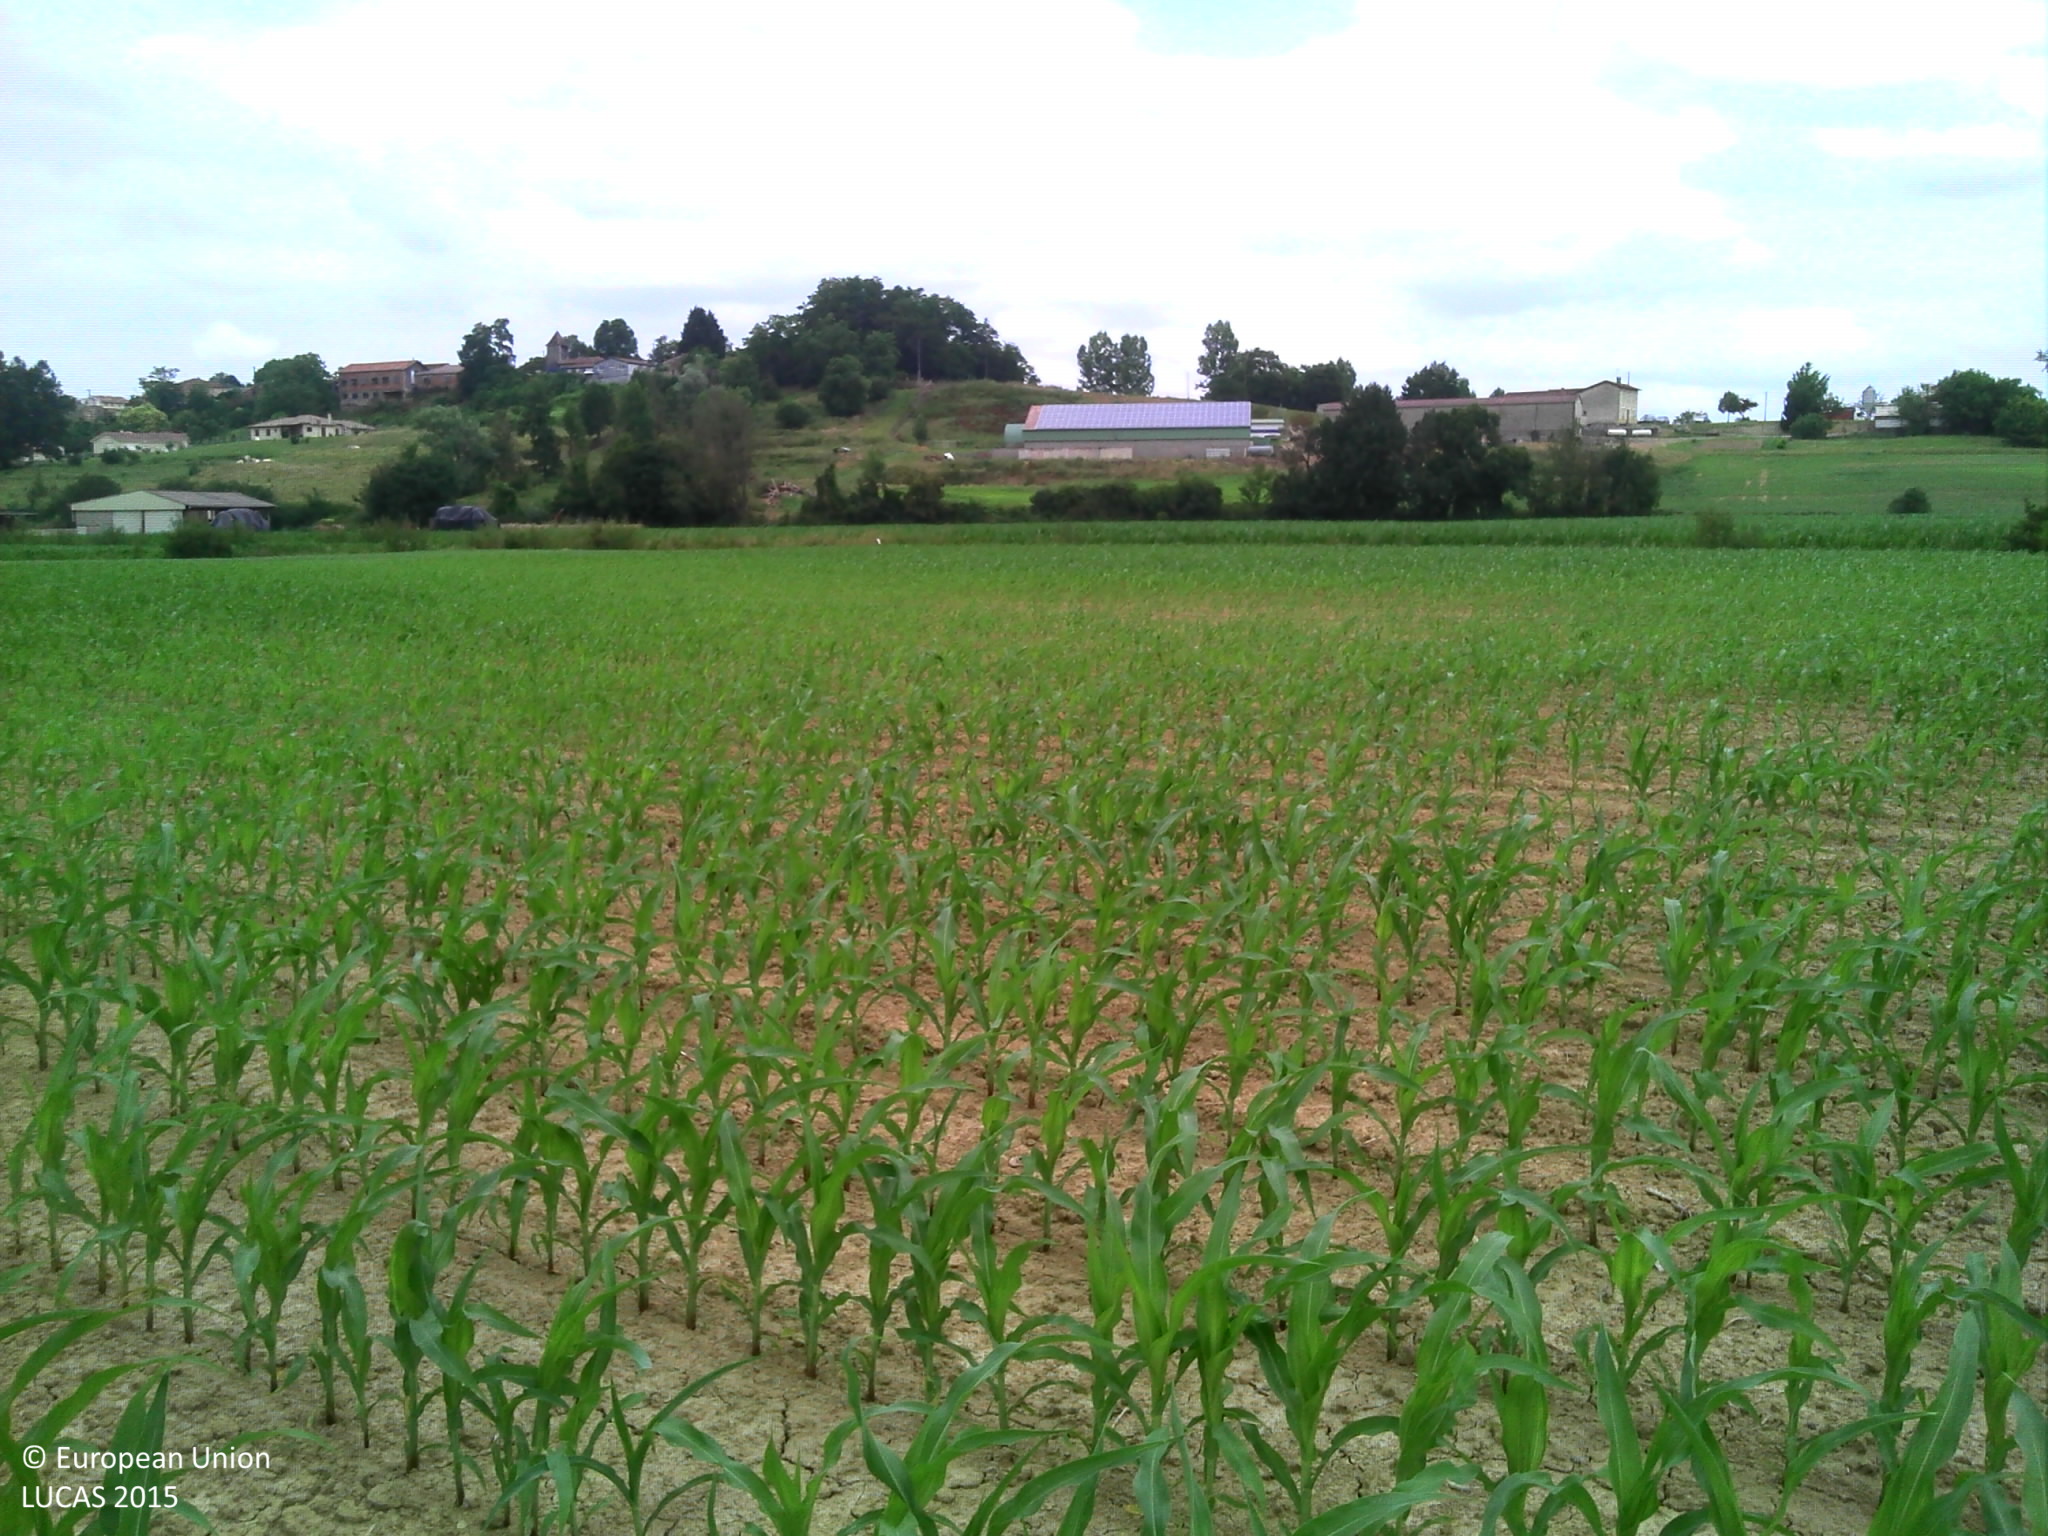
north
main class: Cropland
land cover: Maize
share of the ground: 50 - 75 %
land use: Agriculture (excluding fallow land and kitchen gardens)
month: July
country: FR
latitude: 43.6235
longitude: -0.7818
